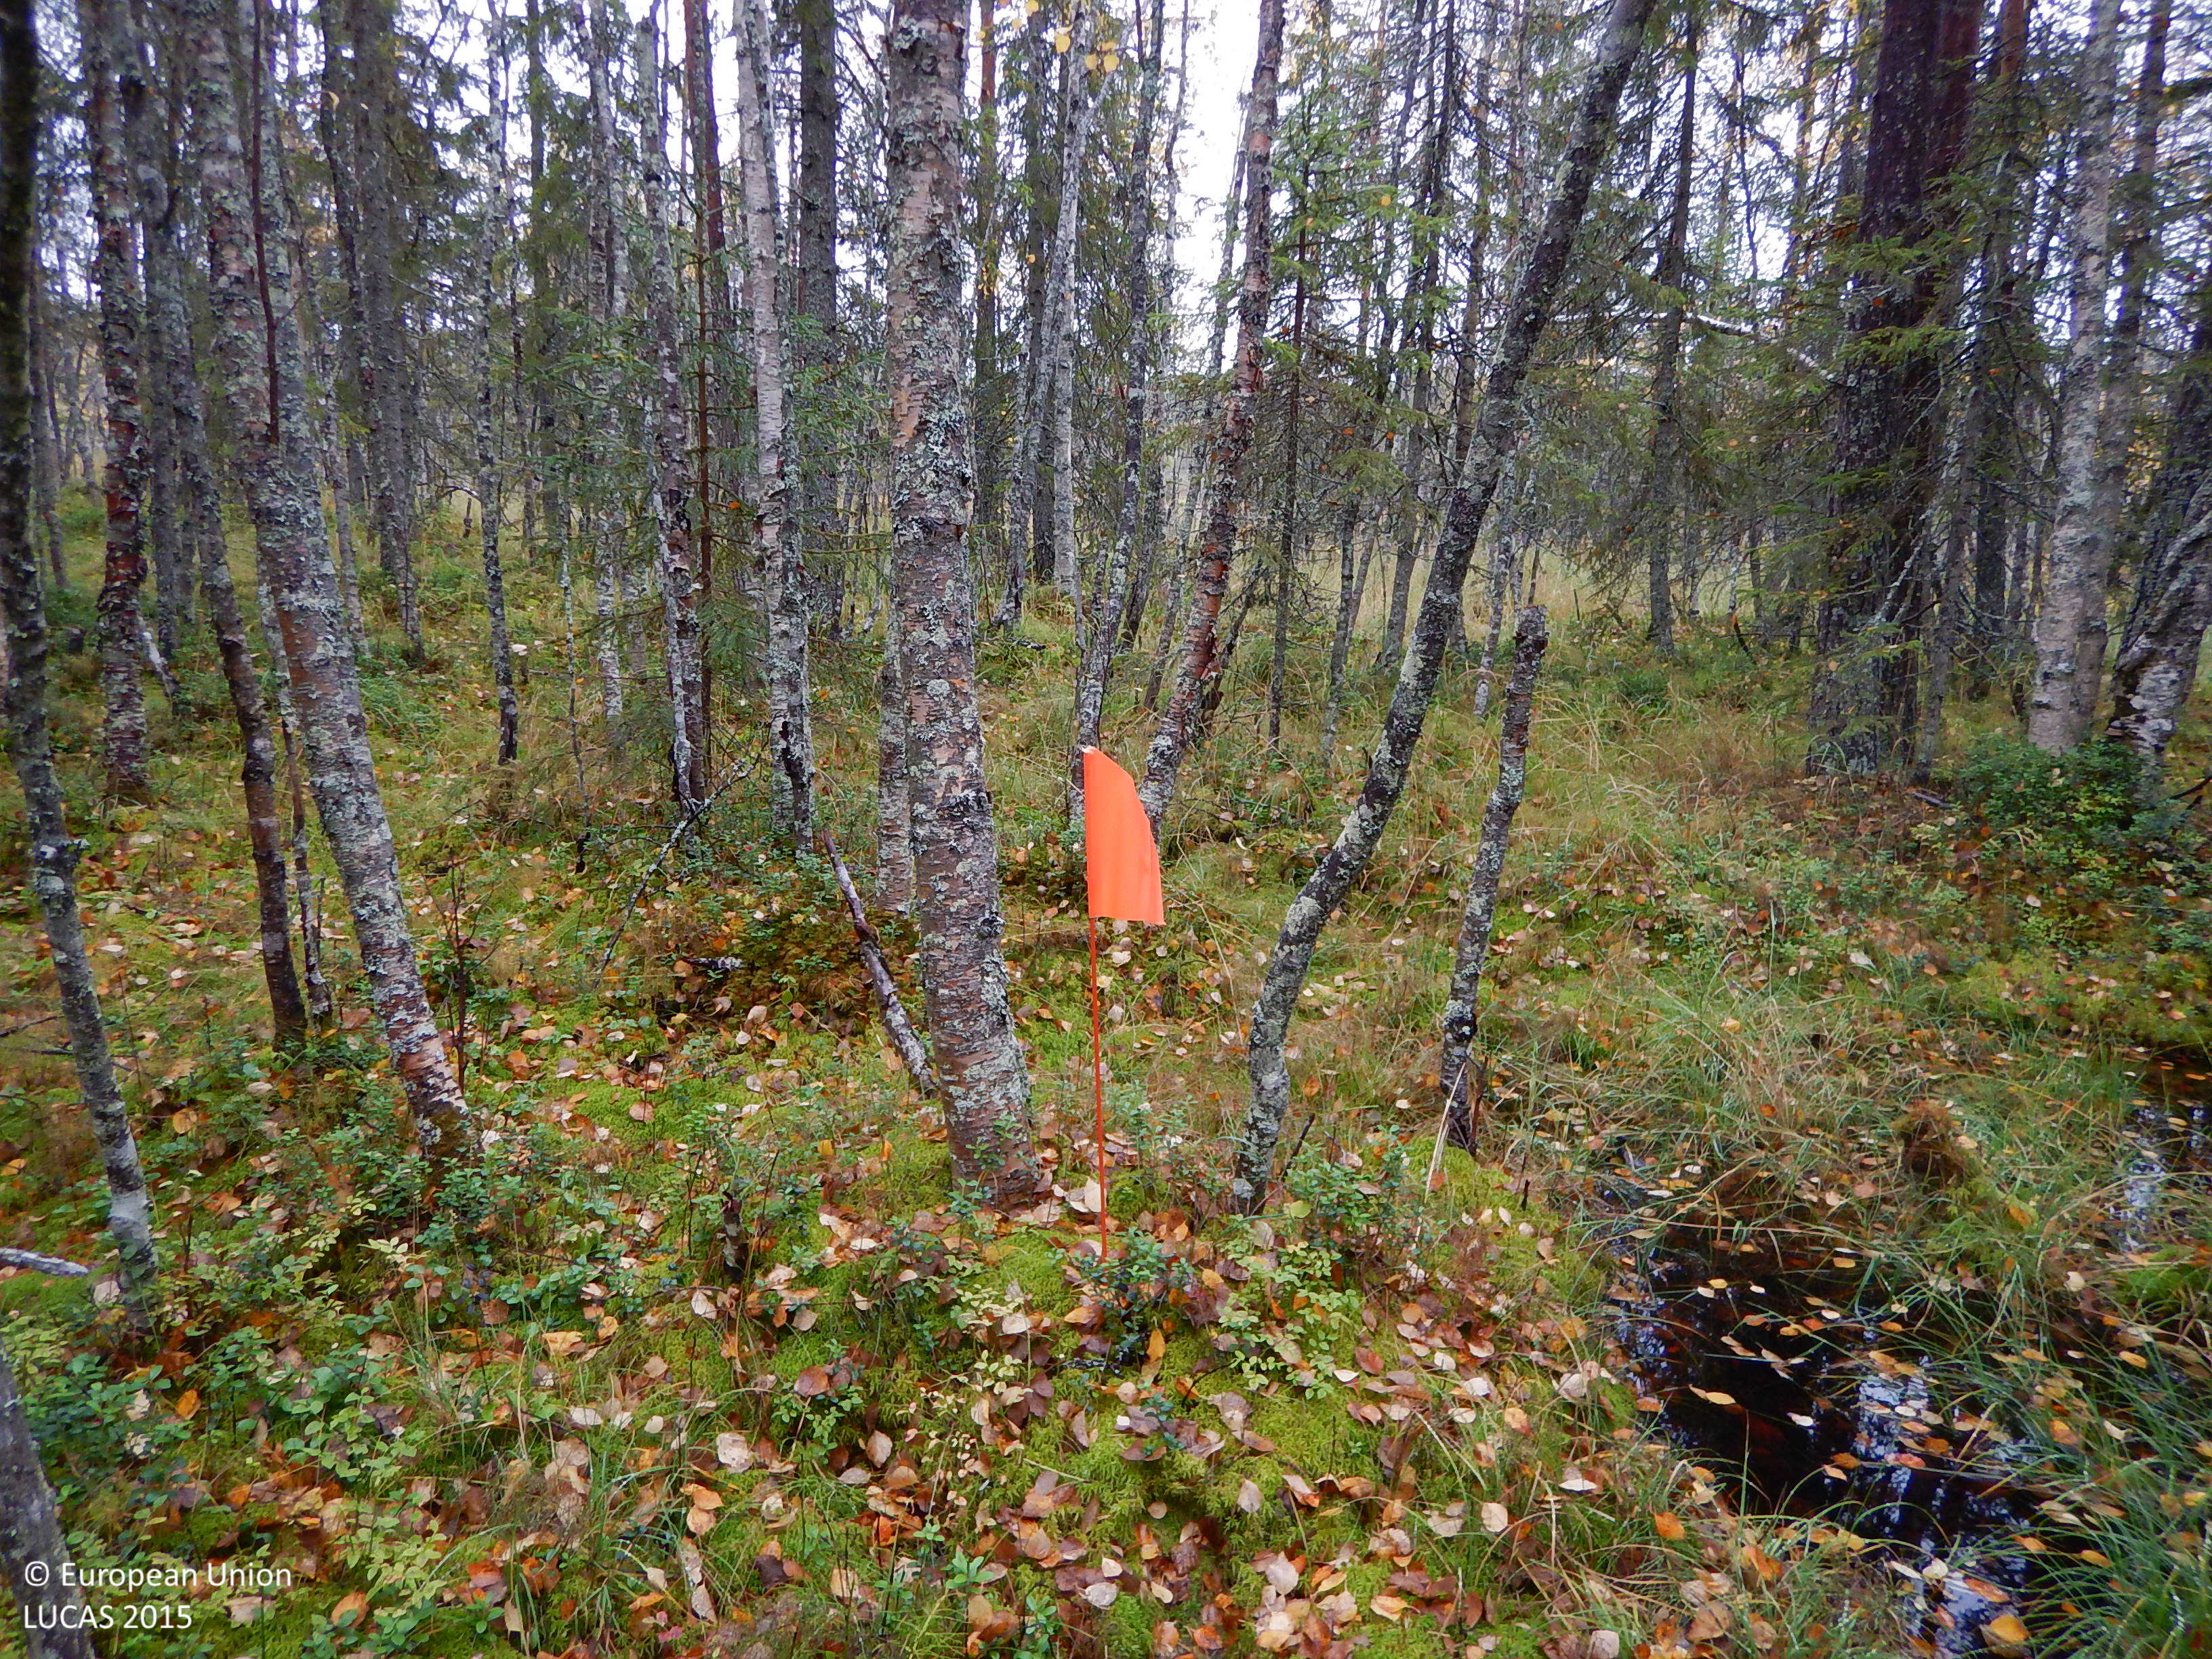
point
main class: Woodland
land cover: Other mixed woodland
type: mire and swamp forests
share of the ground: 50 - 75 %
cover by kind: coniferous forest trees 30 %, broadleaved forest trees 30 %, lichens and mosses 20 %, shrubs 10 %, herbaceous plants 10 %
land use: Amenities, museums, leisure
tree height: > 5 m
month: September
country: SE
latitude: 65.0881
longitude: 19.9470
